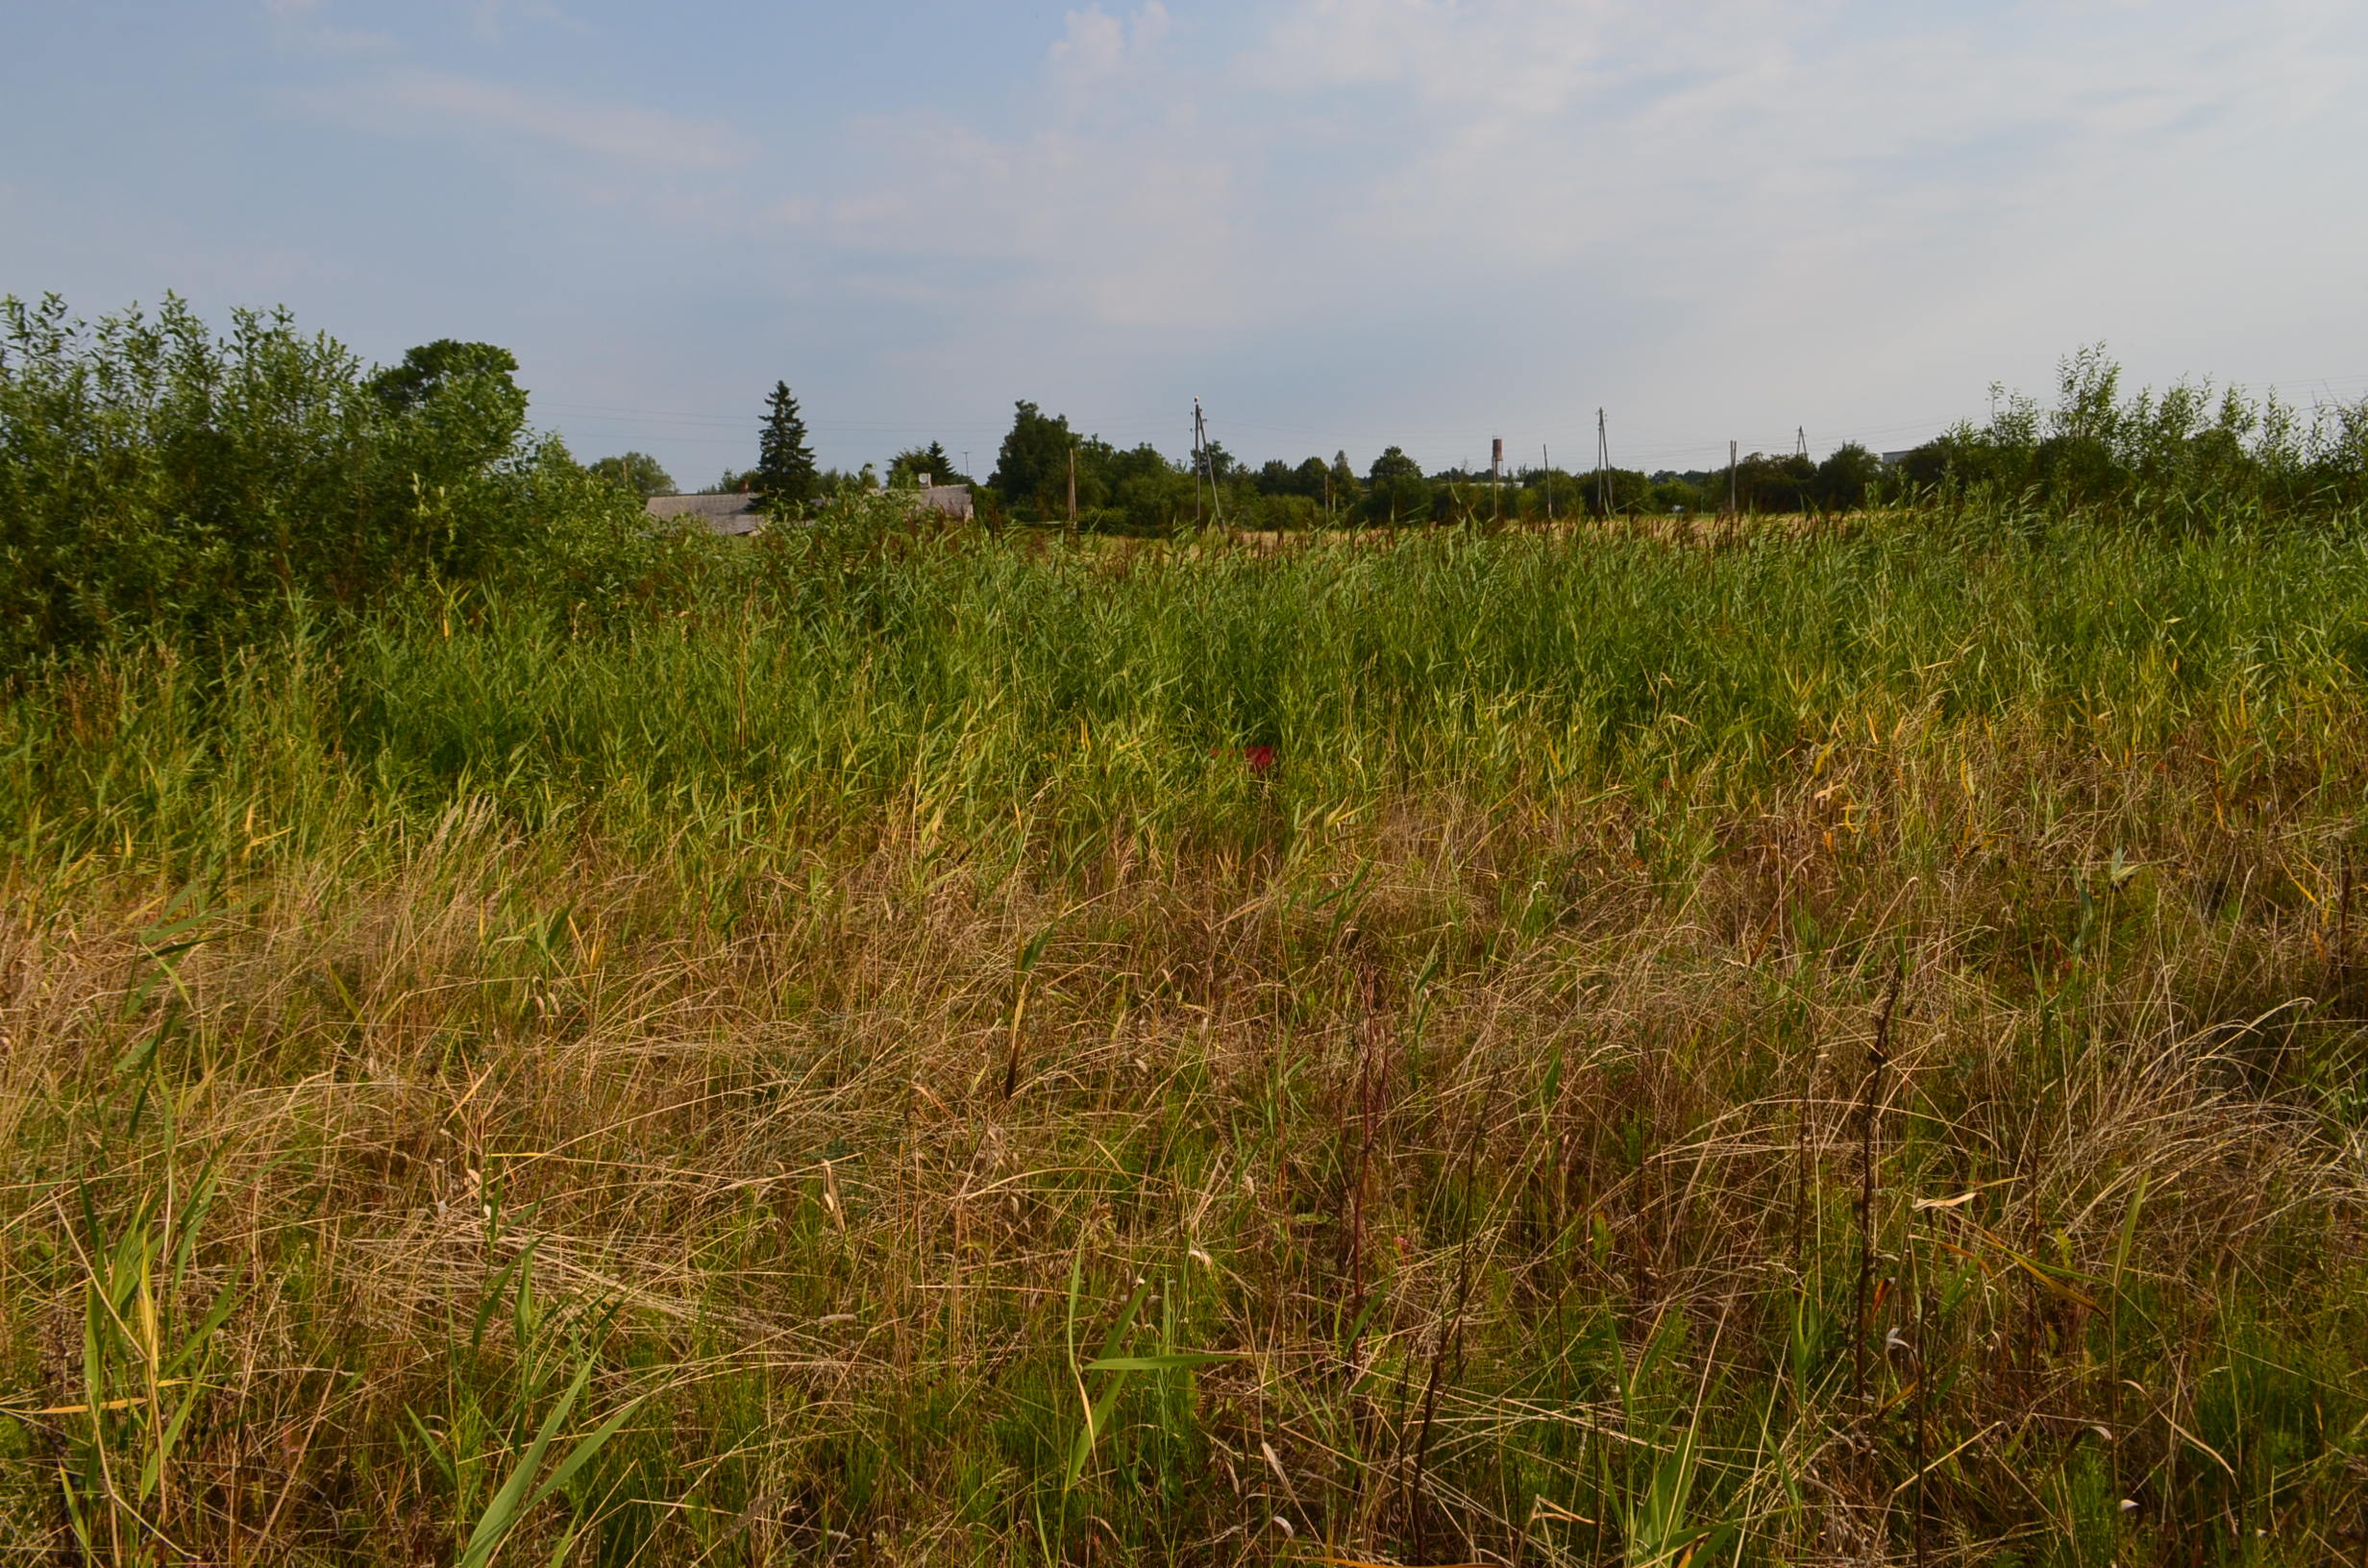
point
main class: Grassland
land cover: Spontaneously vegetated surfaces
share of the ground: > 75 %
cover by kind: herbaceous plants 95 %, shrubs 5 %
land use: Semi-natural and natural areas not in use
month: August
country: LV
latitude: 57.3492
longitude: 21.6236
